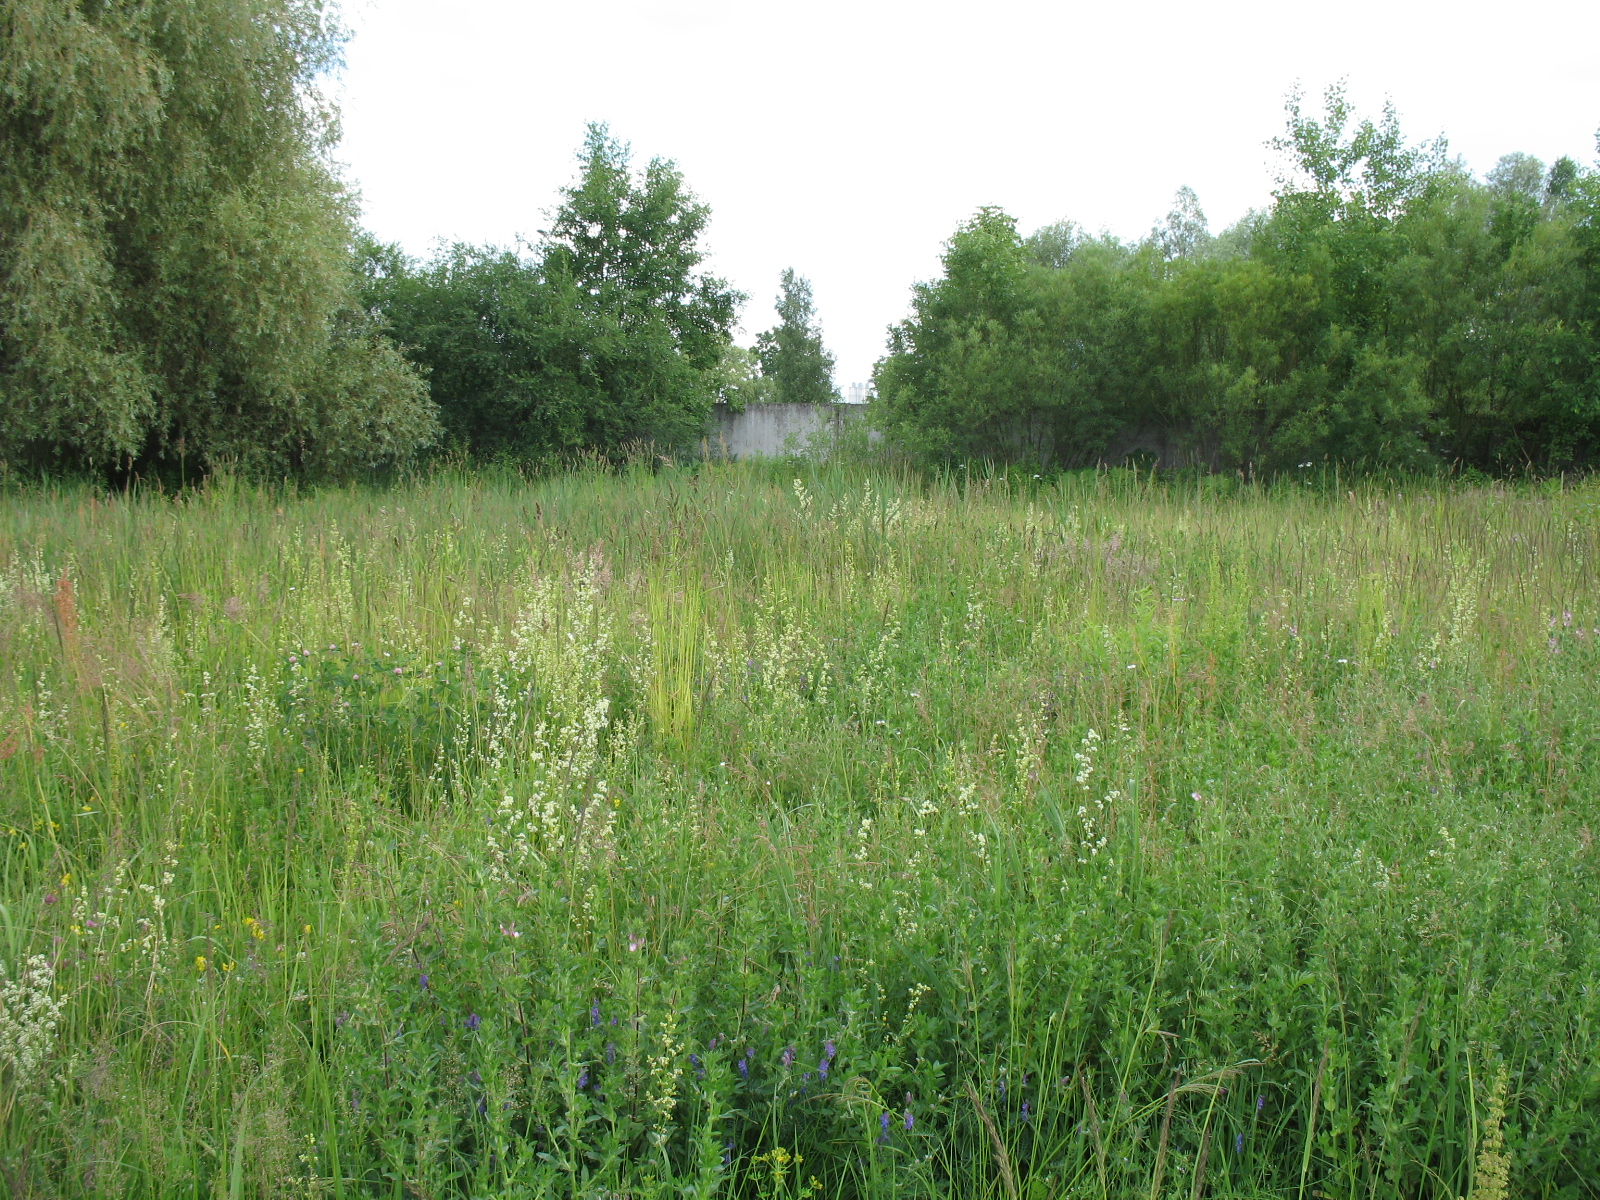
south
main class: Grassland
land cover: Grassland without tree/shrub cover
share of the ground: > 75 %
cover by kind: herbaceous plants 100 %
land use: Abandoned areas
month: June
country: LV
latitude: 56.6650
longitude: 23.7690
